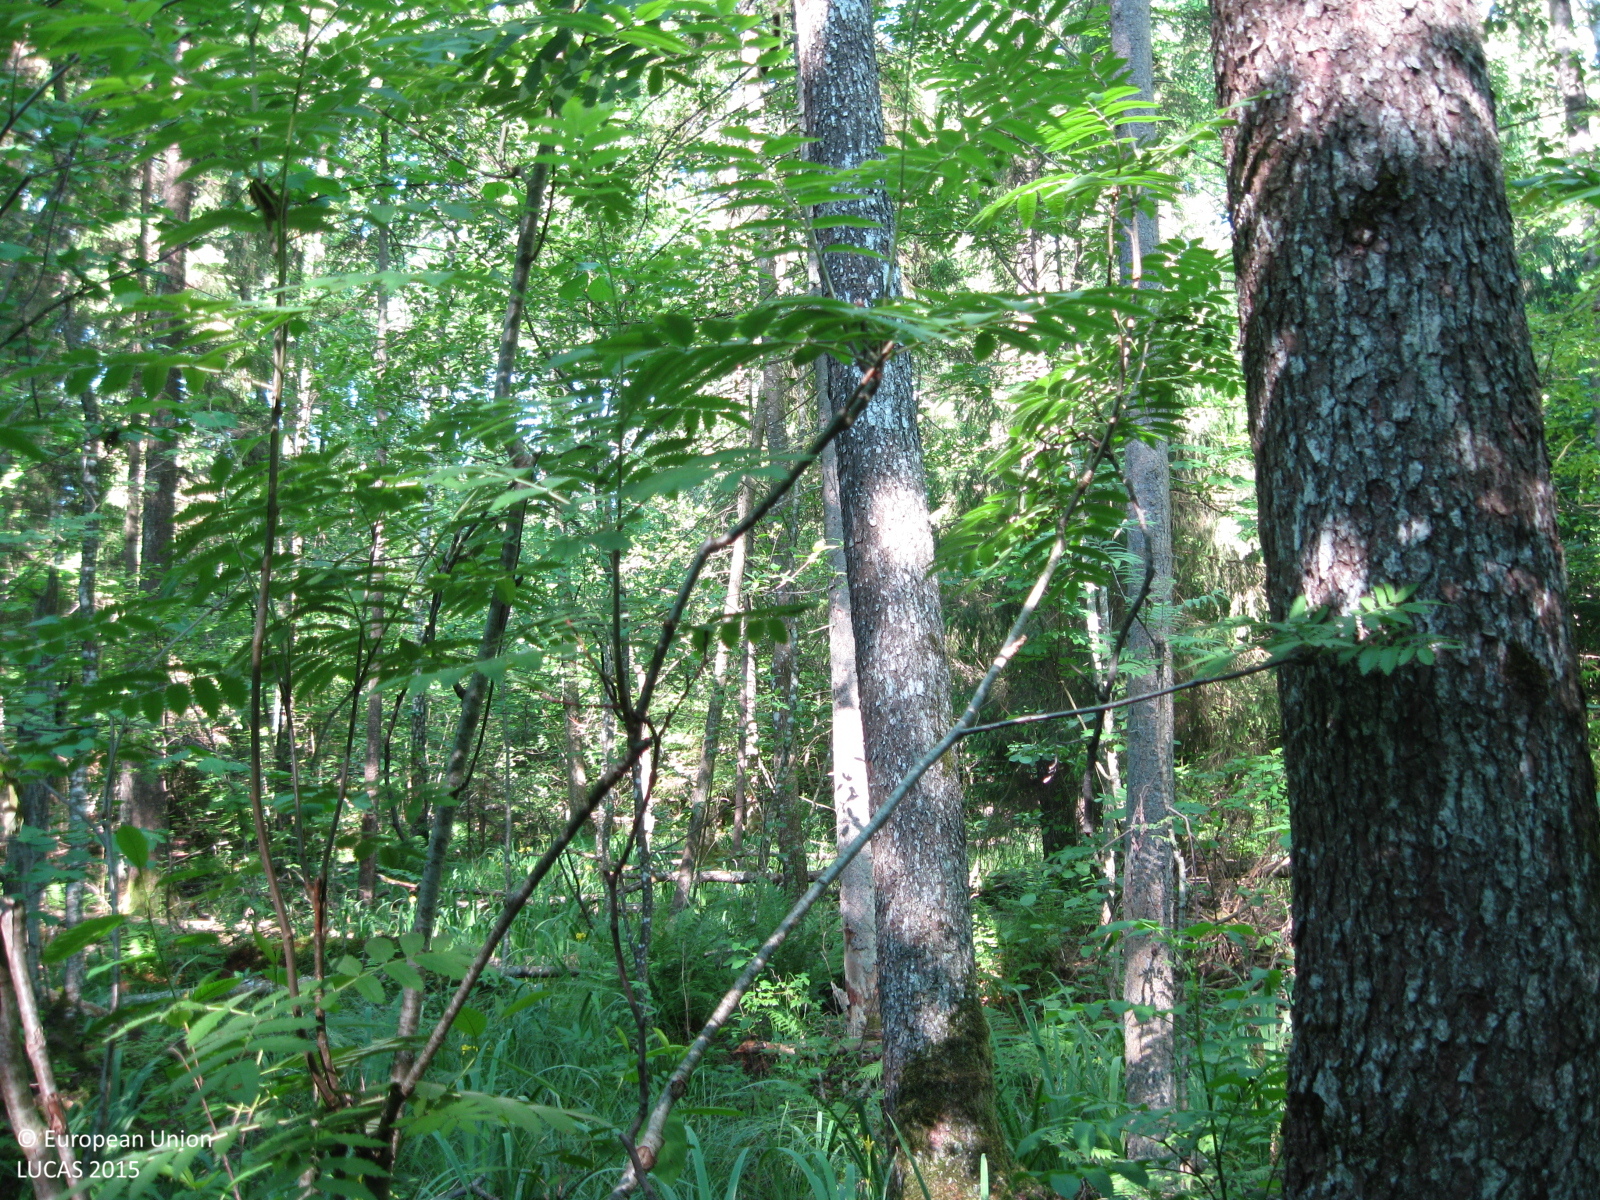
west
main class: Woodland
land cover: Spruce dominated mixed woodland
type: hemiboreal forest and nemoral coniferous forest and mixed broadleaved-coniferous forest
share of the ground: > 75 %
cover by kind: broadleaved forest trees 45 %, coniferous forest trees 35 %, herbaceous plants 20 %
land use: Forestry
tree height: > 5 m
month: June
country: LT
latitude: 55.3295
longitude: 23.7829
